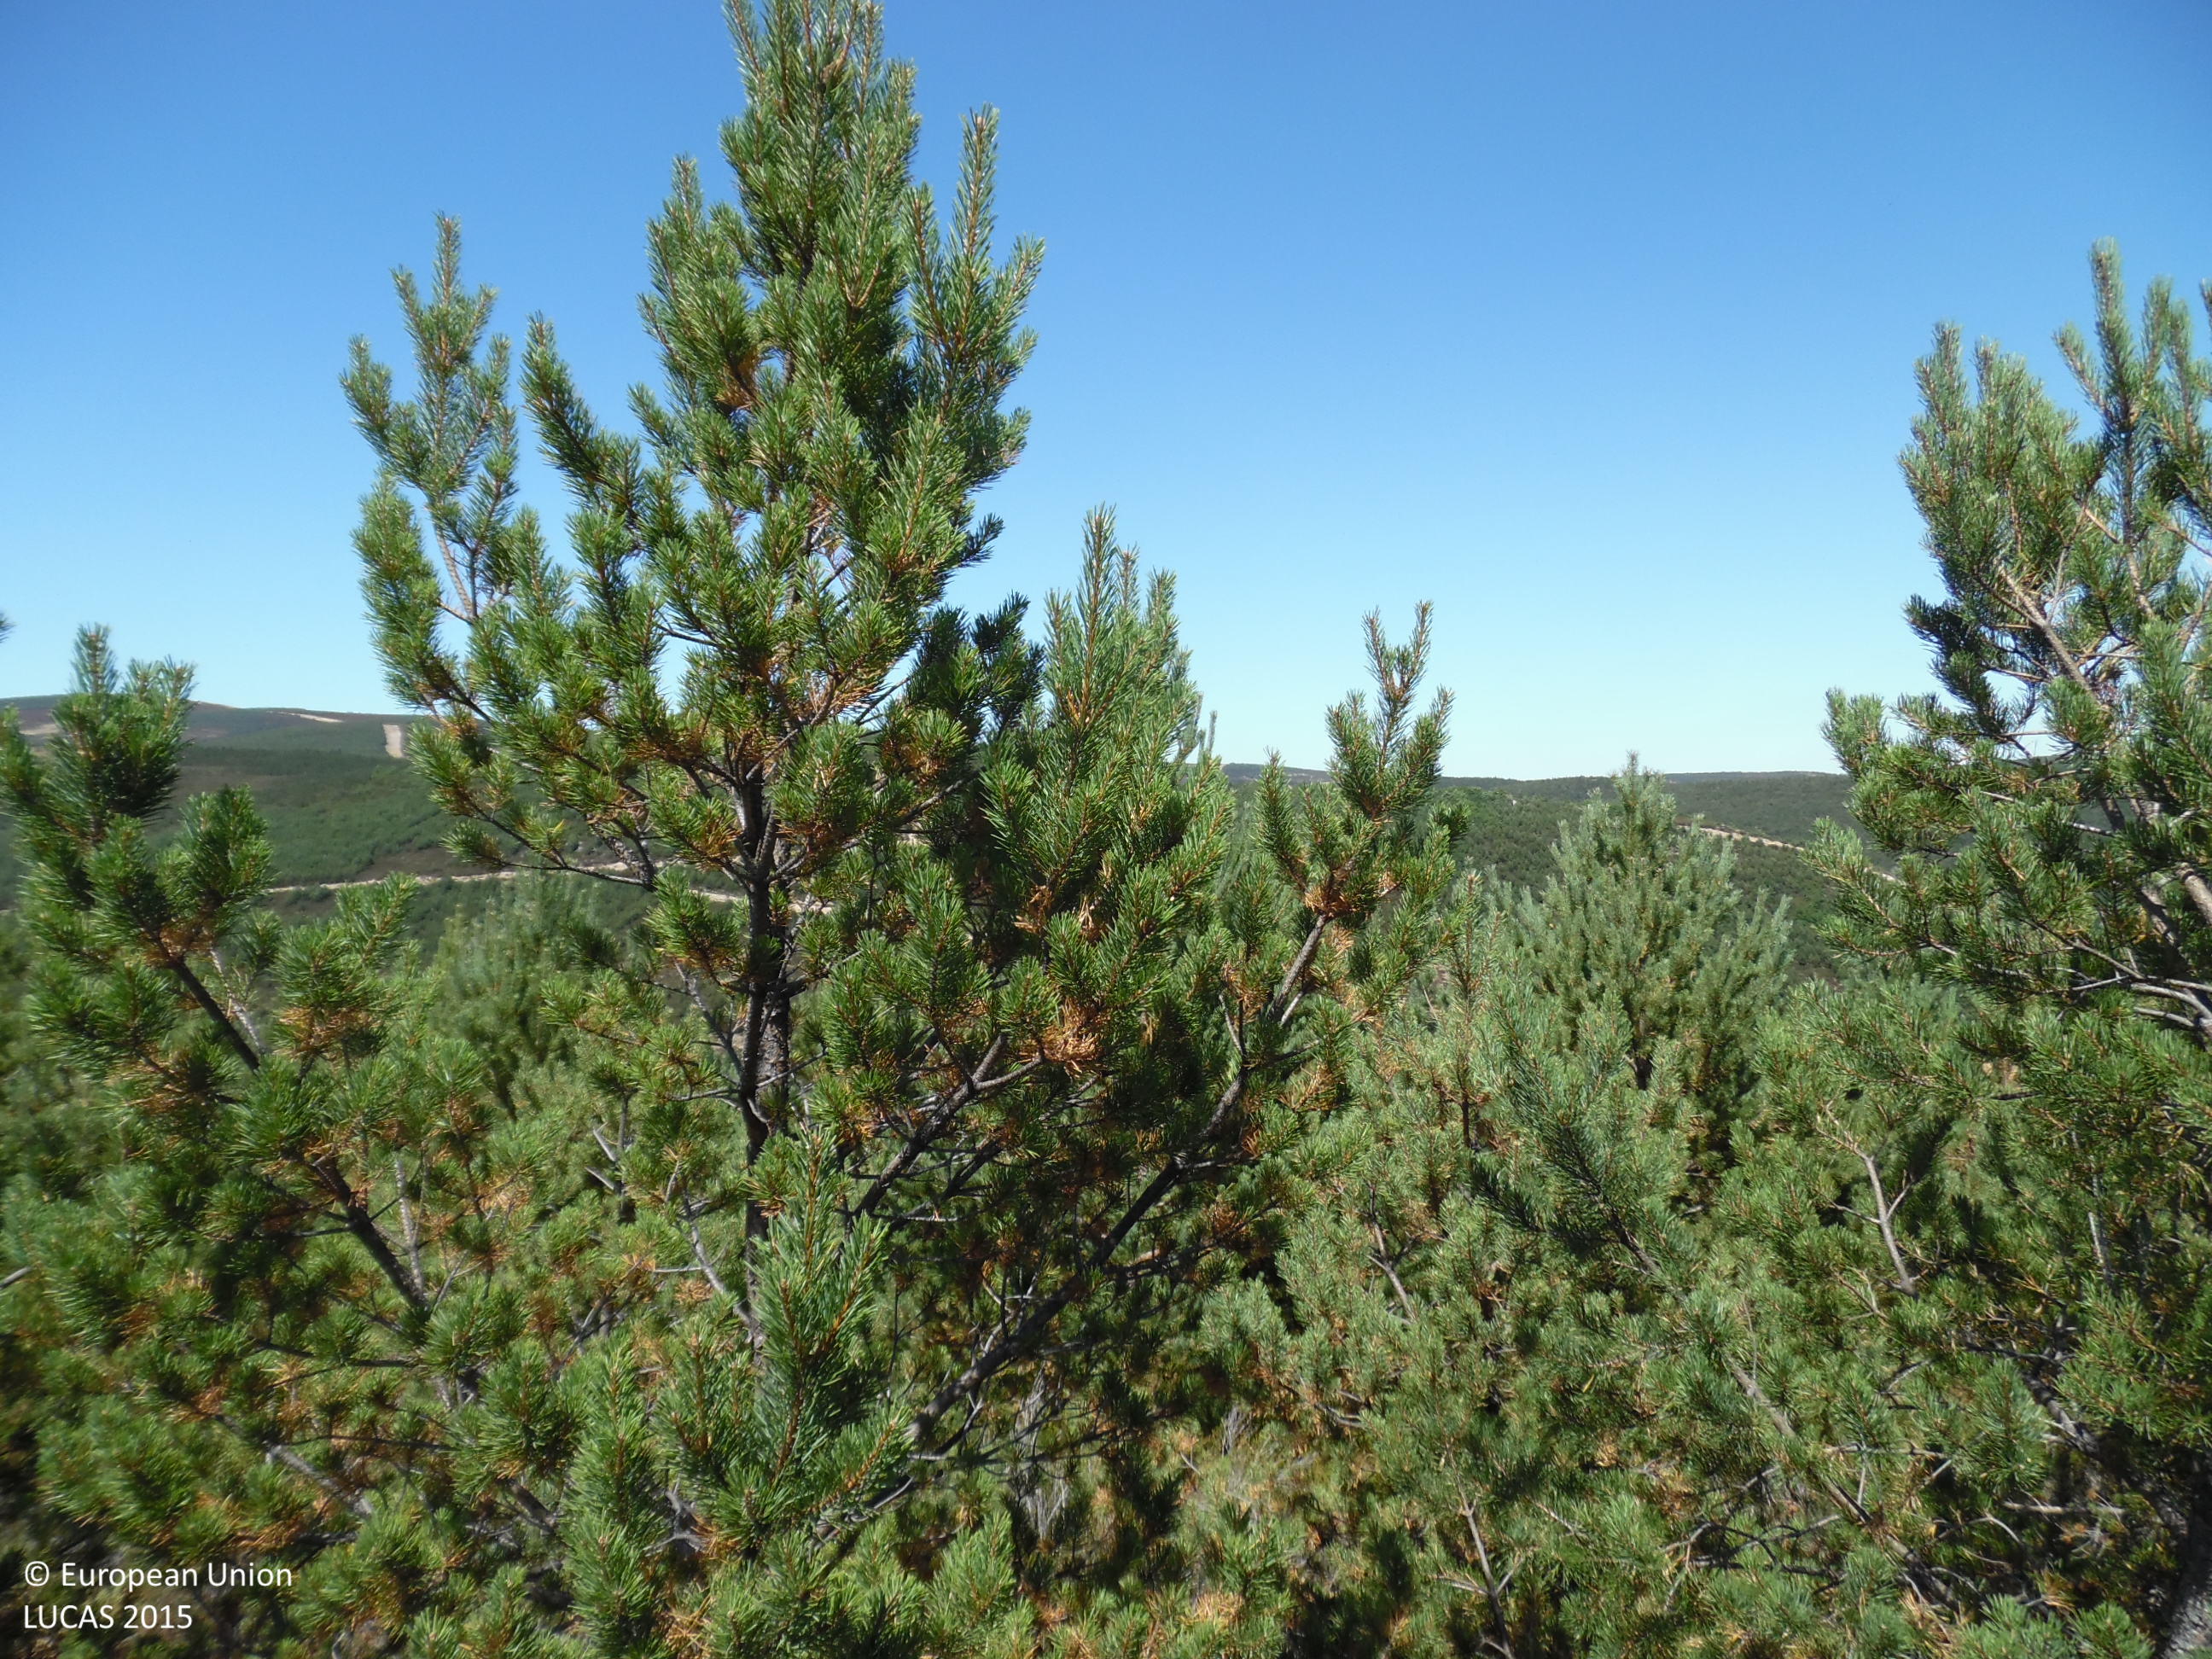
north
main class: Woodland
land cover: Pine dominated coniferous woodland
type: coniferous forest of the mediterranean region
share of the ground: > 75 %
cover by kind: coniferous forest trees 100 %
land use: Forestry
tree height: > 5 m
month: August
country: ES
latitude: 42.7307
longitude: -6.1228
